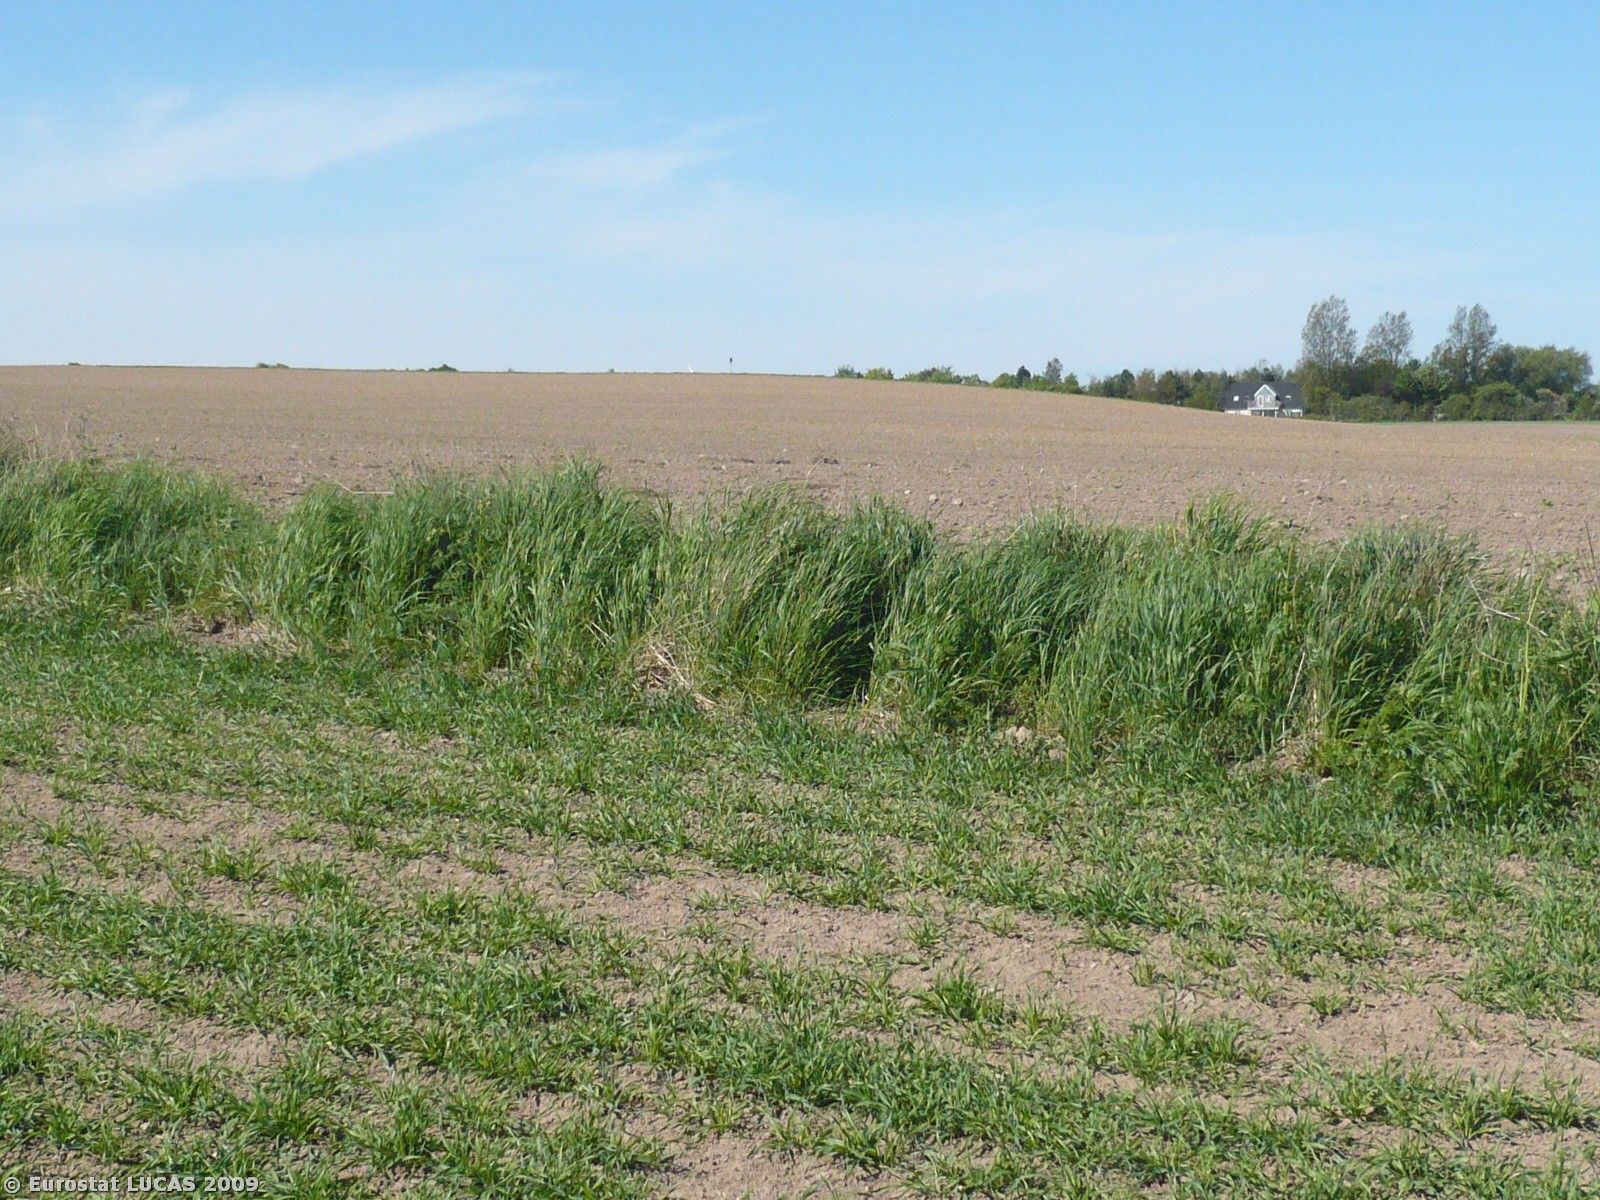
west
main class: Grassland
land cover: Grassland without tree/shrub cover
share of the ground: > 75 %
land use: Agriculture (excluding fallow land and kitchen gardens)
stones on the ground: < 10 %
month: May
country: DK
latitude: 55.1654
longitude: 11.9922
